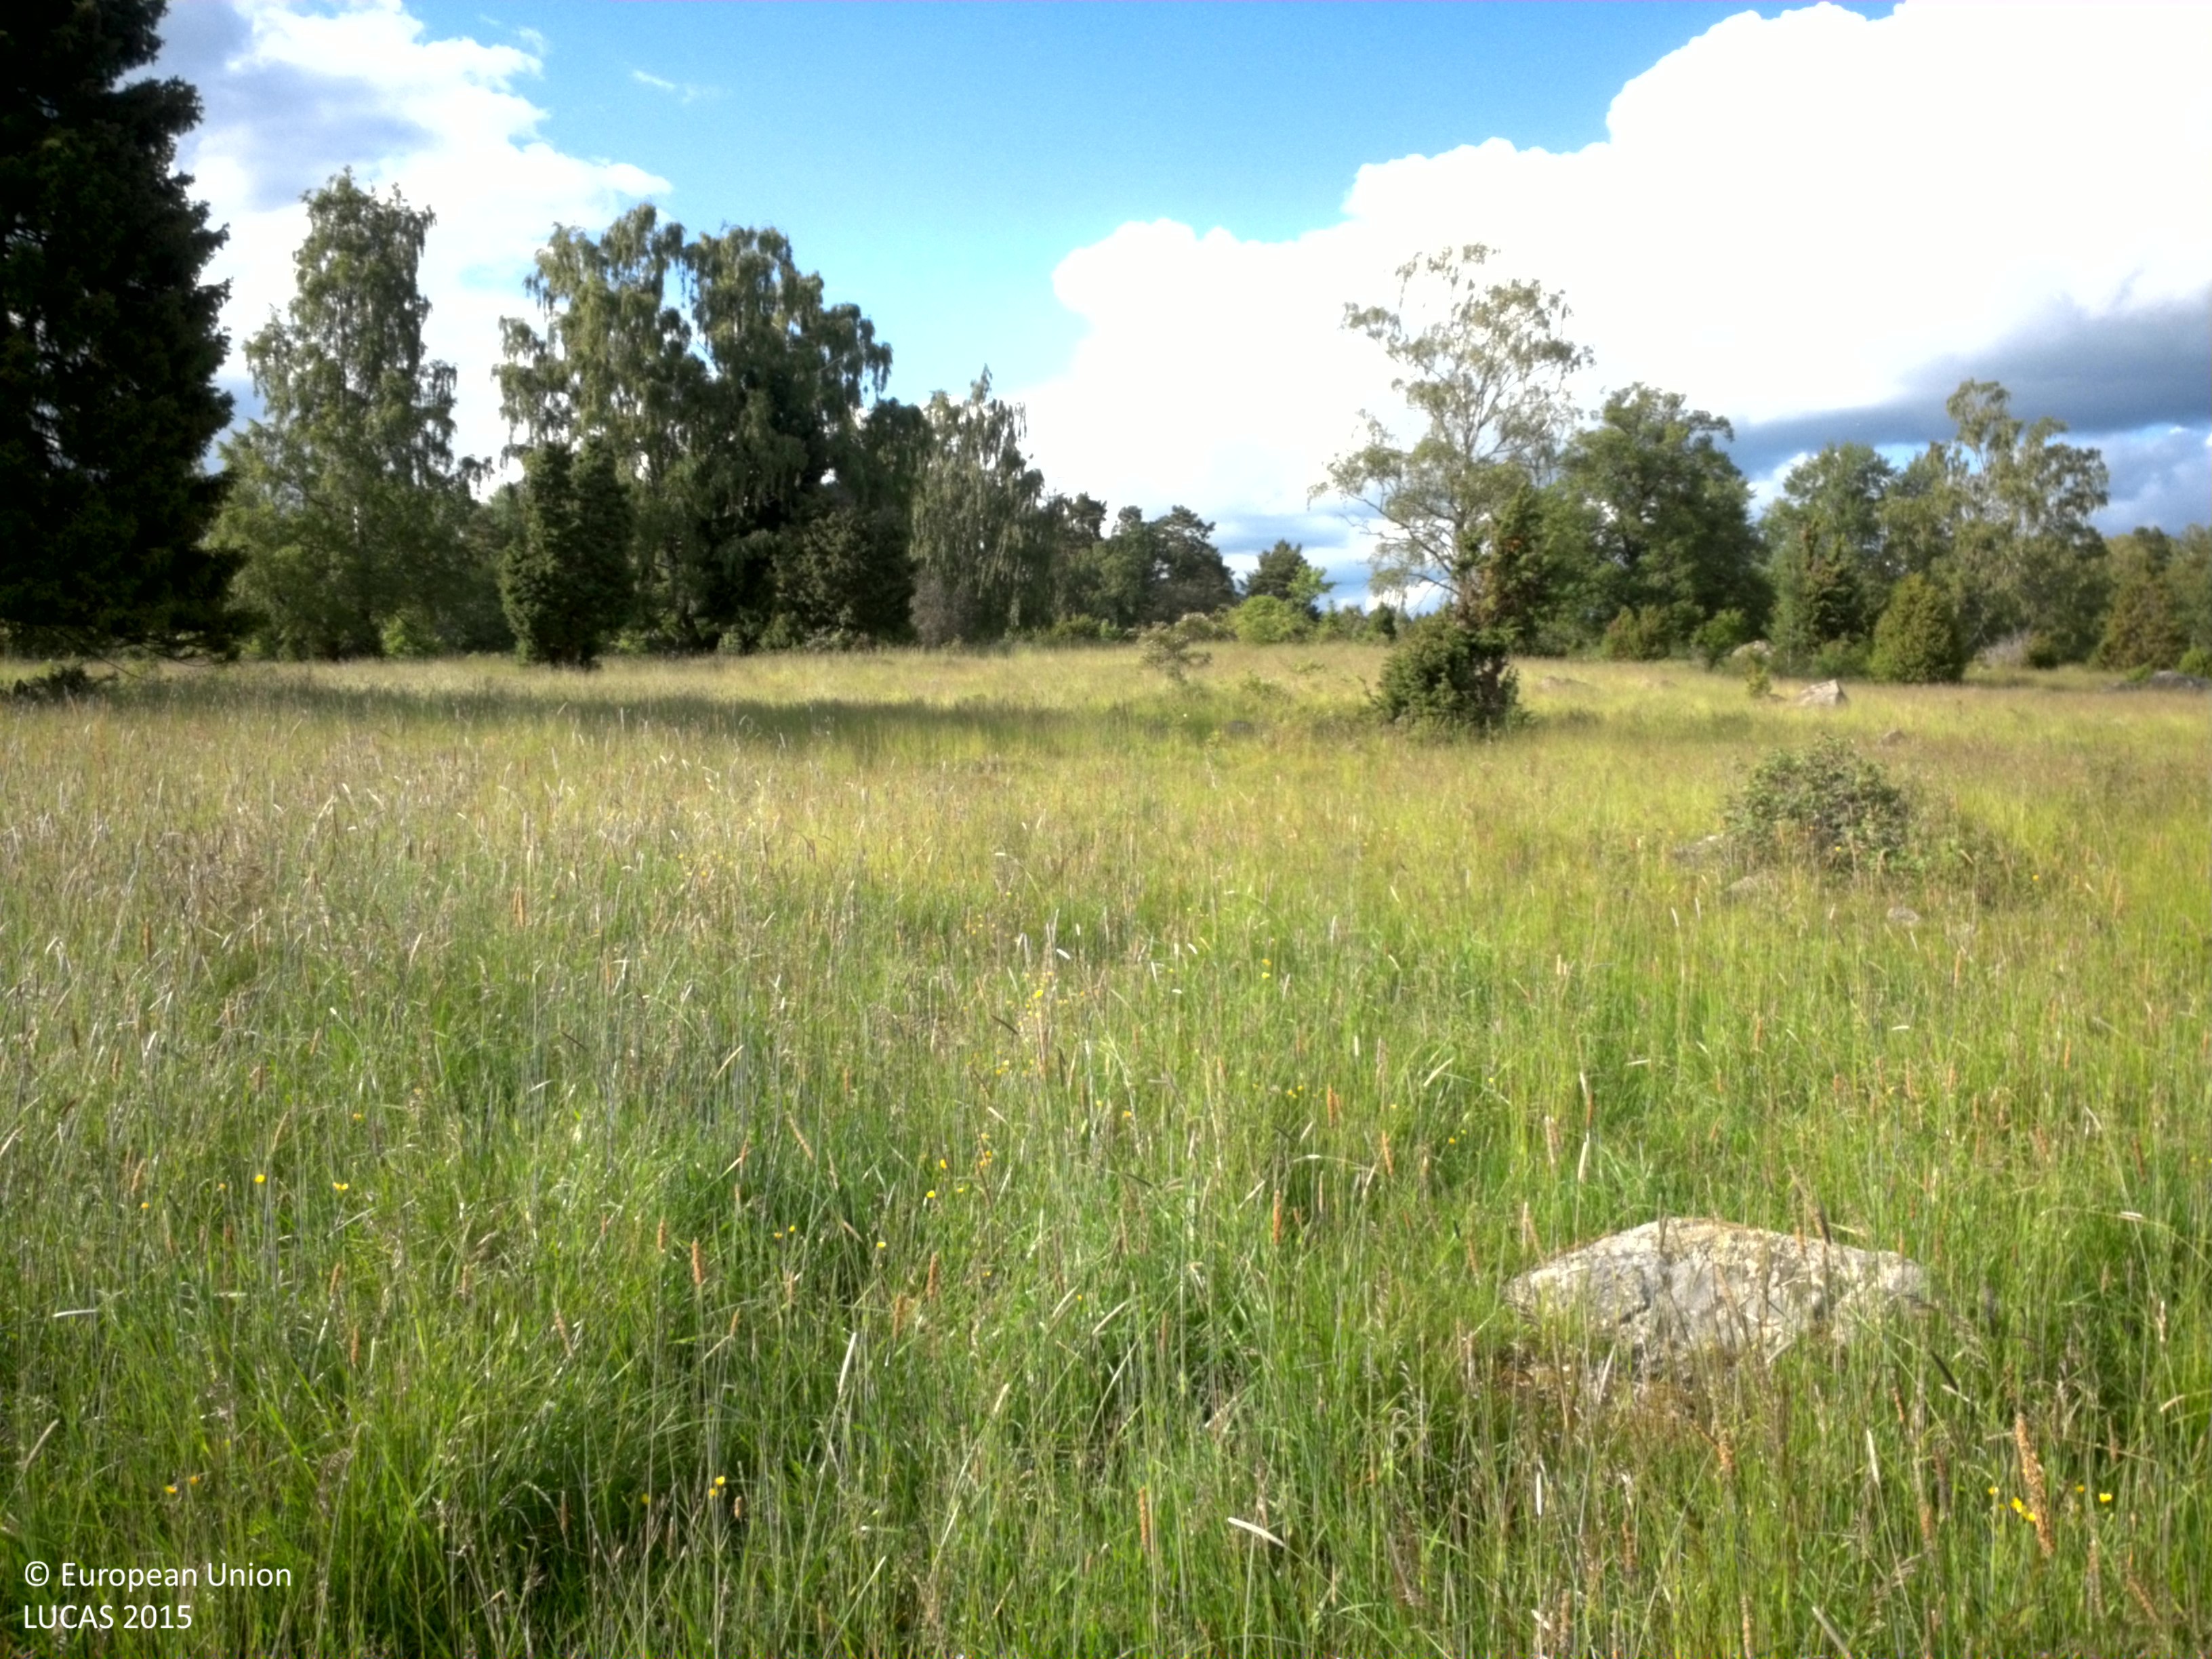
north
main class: Grassland
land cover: Grassland with sparse tree/shrub cover
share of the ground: 10 - 25 %
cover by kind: herbaceous plants 80 %, lichens and mosses 10 %, coniferous forest trees 5 %, shrubs 5 %
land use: Agriculture (excluding fallow land and kitchen gardens)
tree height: > 5 m
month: June
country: SE
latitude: 59.7431
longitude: 17.8779
